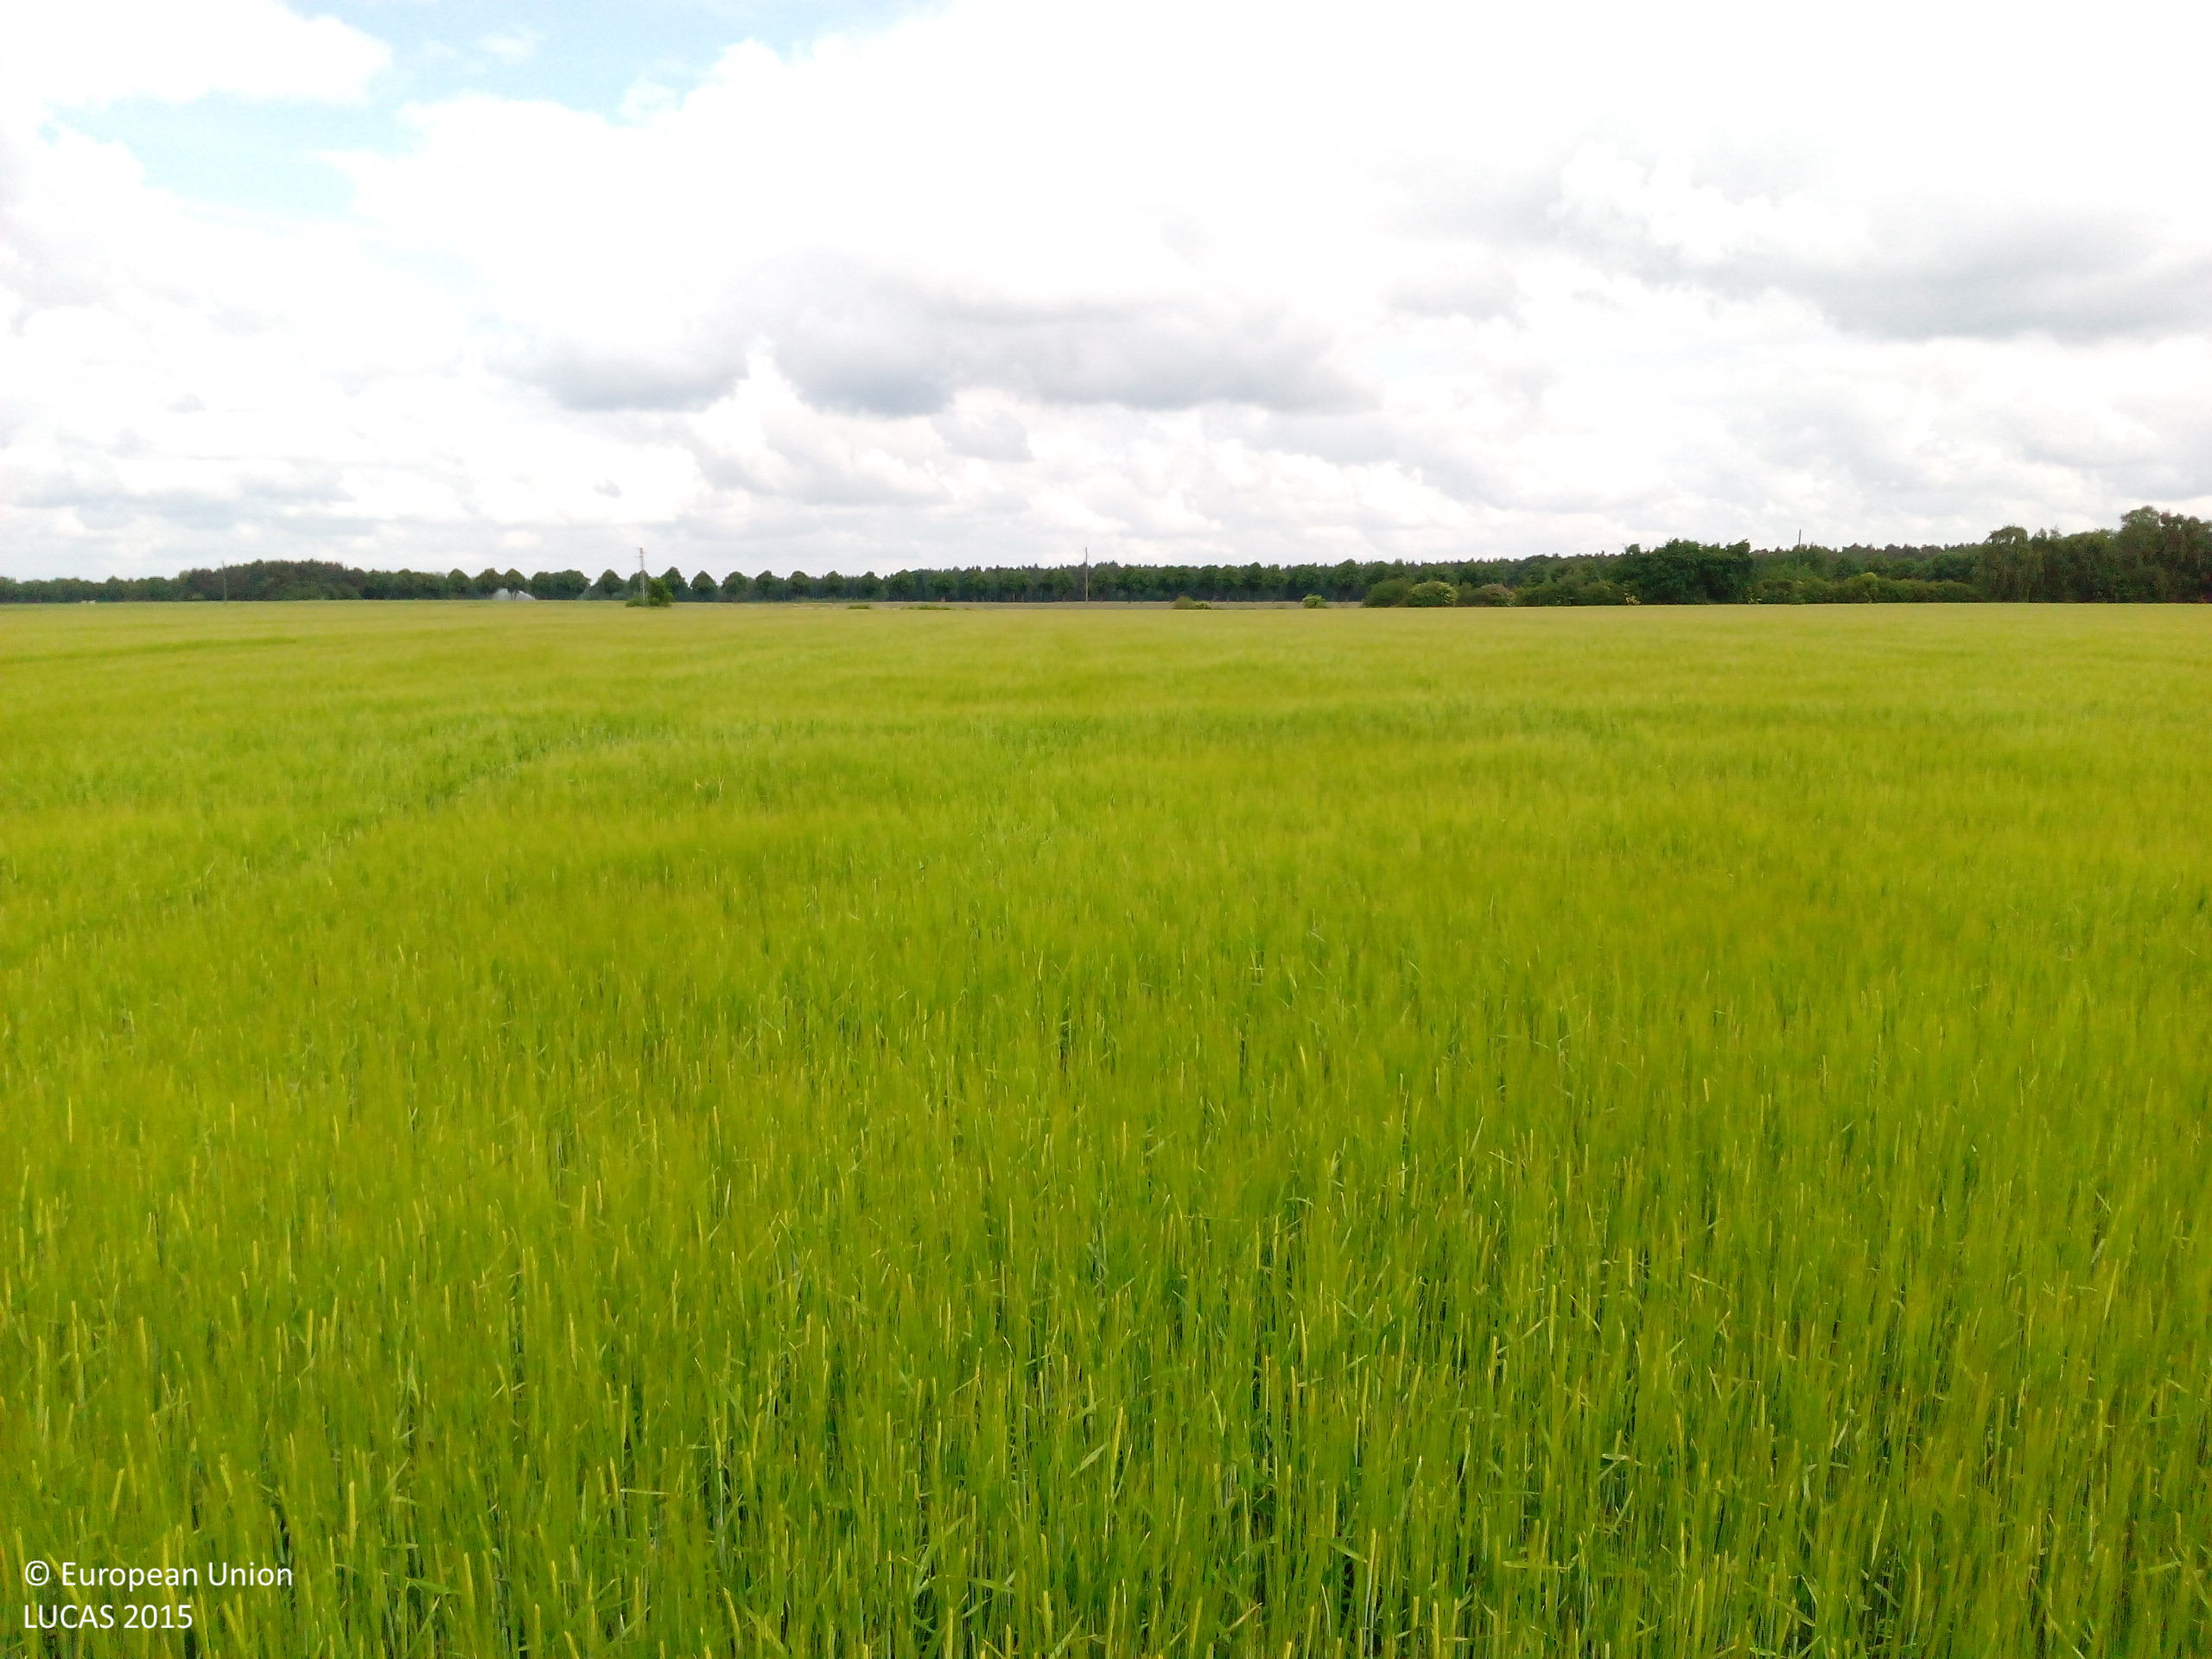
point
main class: Cropland
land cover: Barley
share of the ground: > 75 %
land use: Agriculture (excluding fallow land and kitchen gardens)
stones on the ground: < 10 %
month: June
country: DE
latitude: 52.5361
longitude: 10.8695
